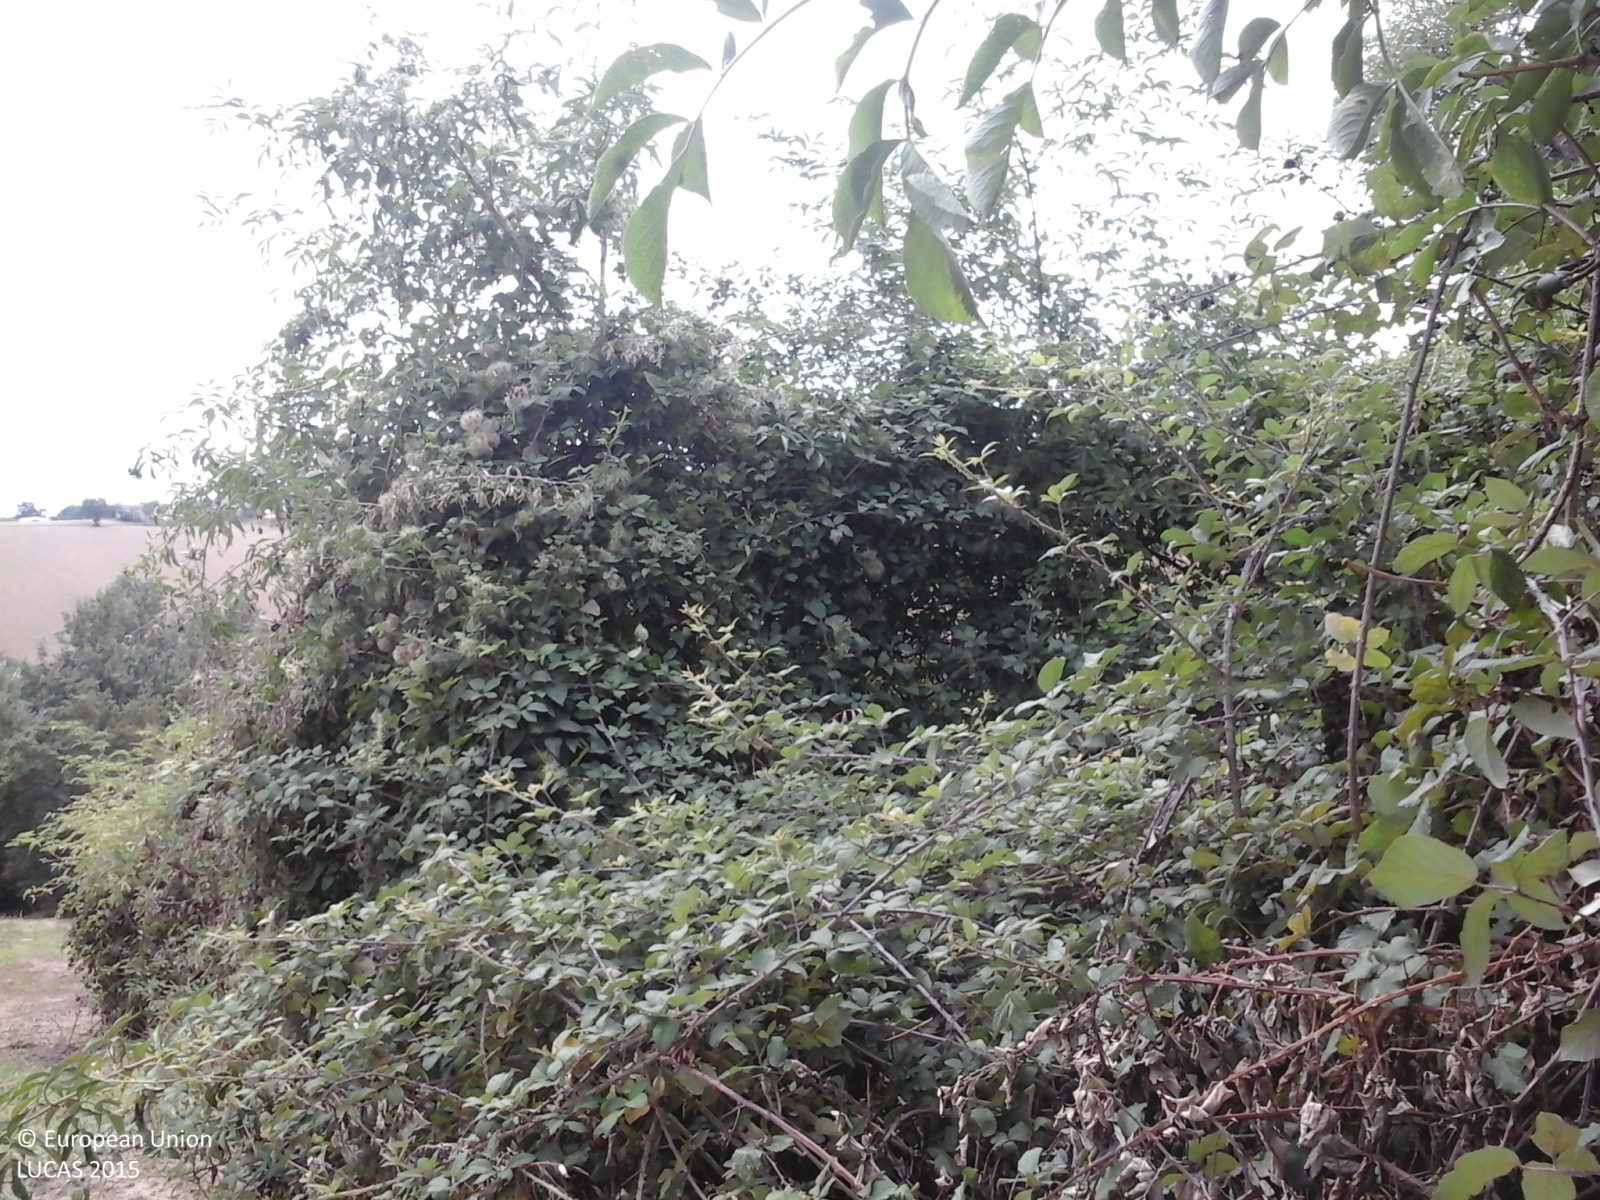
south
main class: Woodland
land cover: Broadleaved woodland
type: thermophilous deciduous forest
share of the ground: 50 - 75 %
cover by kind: broadleaved forest trees 95 %, shrubs 5 %
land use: Forestry
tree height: > 5 m
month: August
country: IT
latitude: 43.3462
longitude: 13.1376
